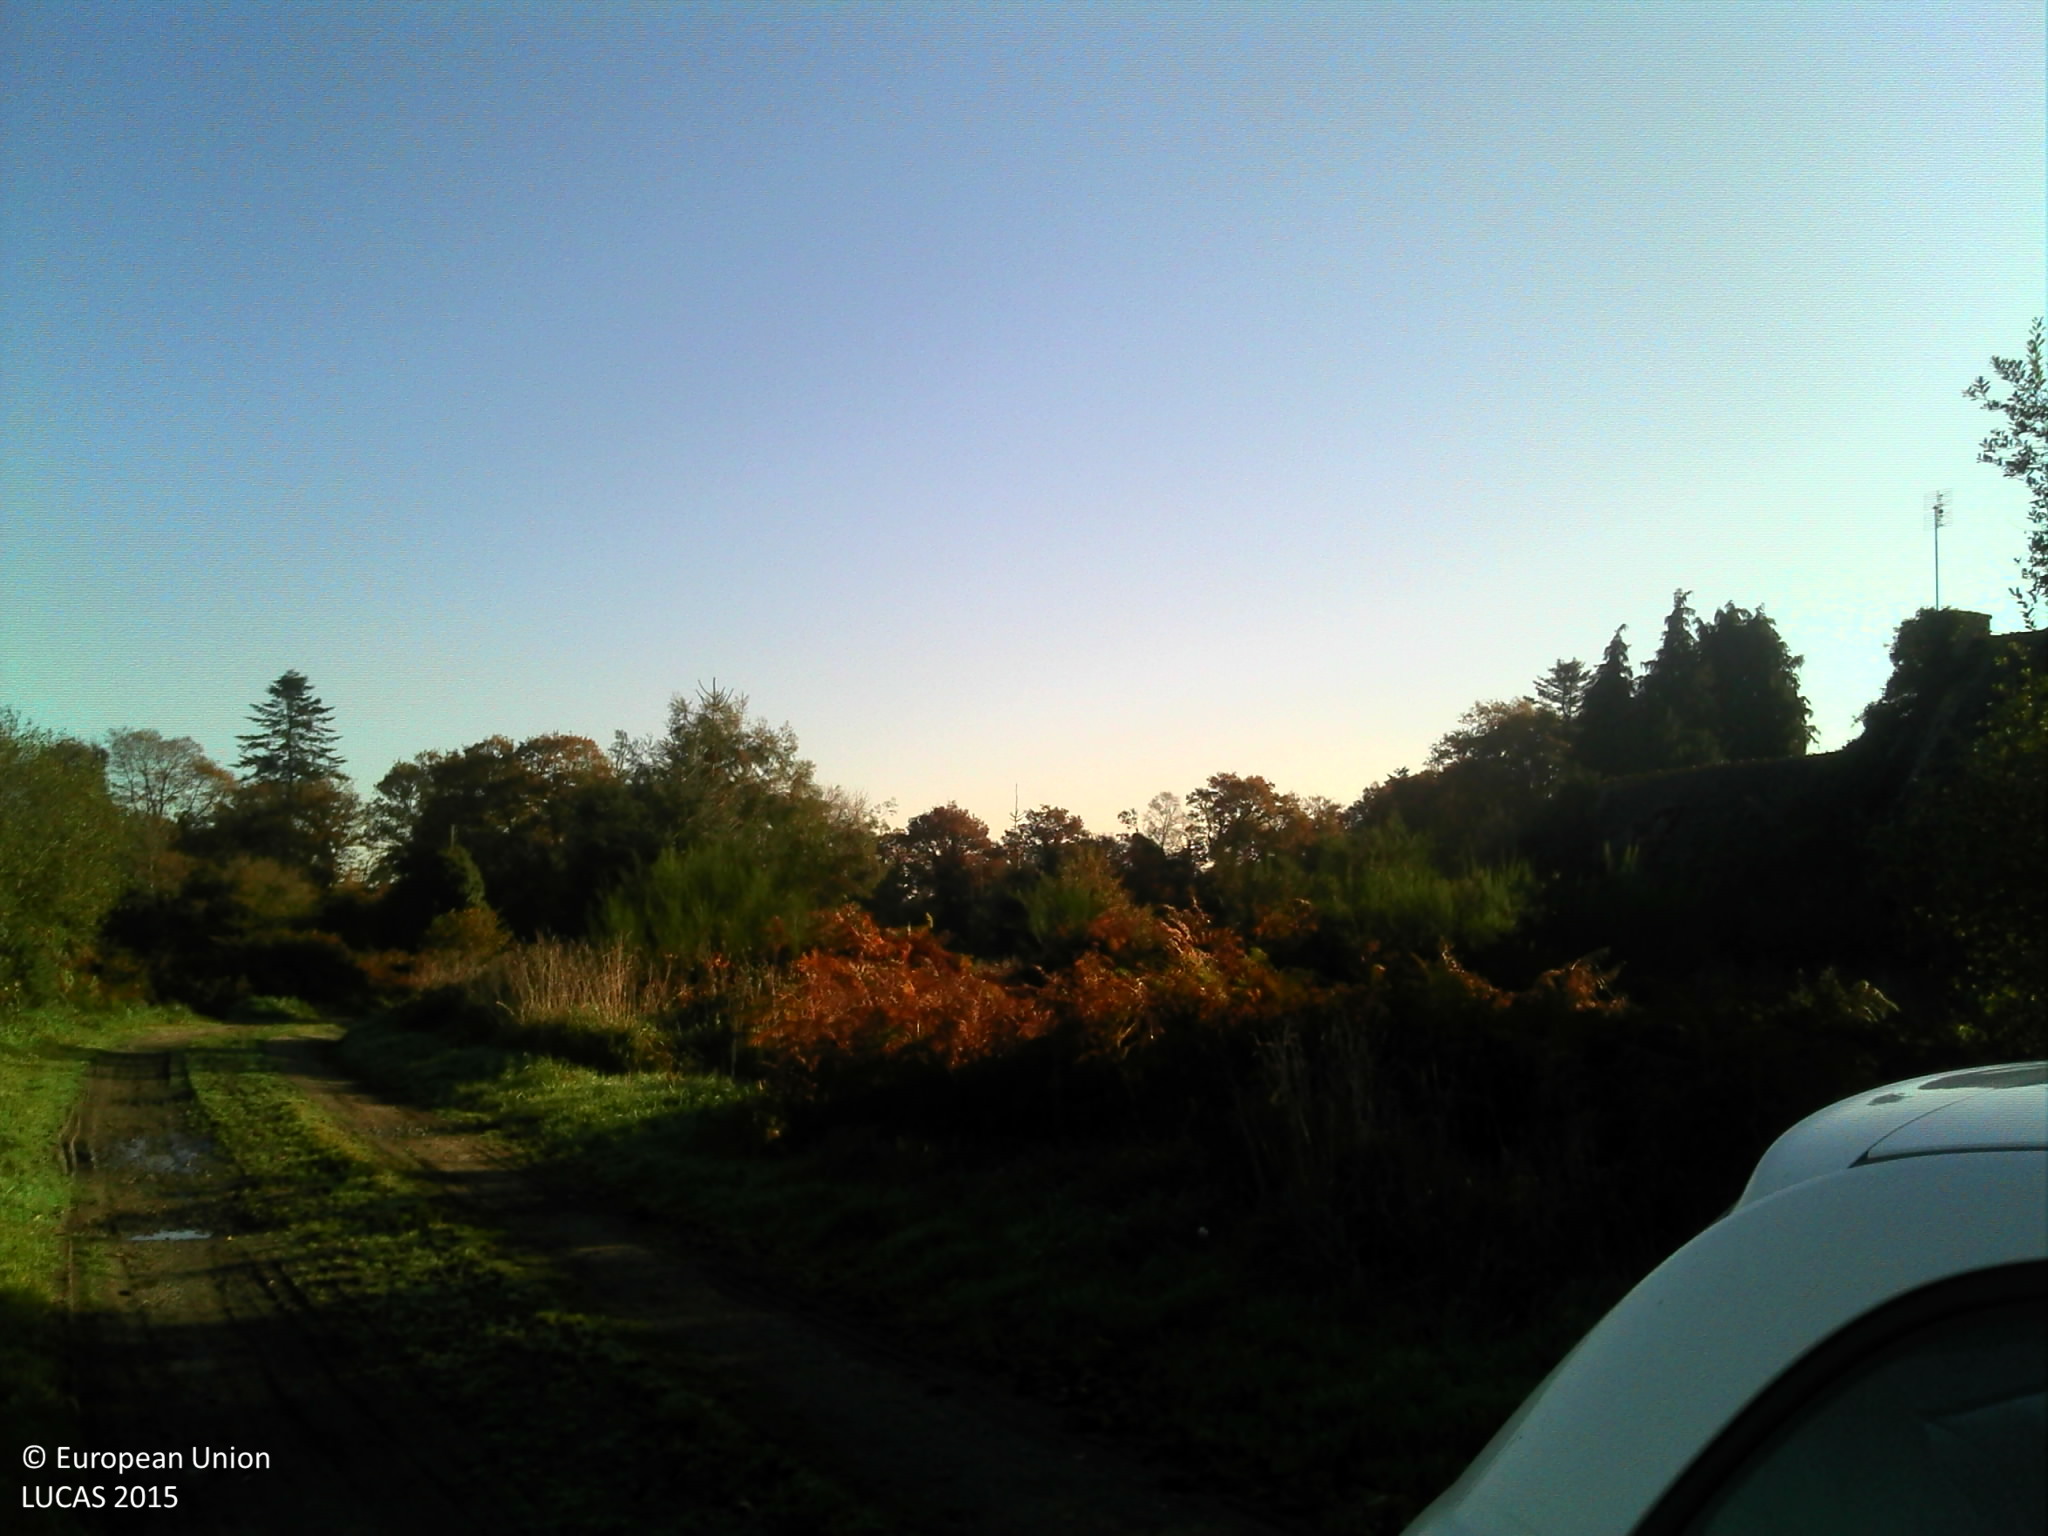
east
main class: Grassland
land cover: Grassland without tree/shrub cover
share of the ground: > 75 %
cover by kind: herbaceous plants 100 %
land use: Agriculture (excluding fallow land and kitchen gardens)
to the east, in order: Grassland without tree/shrub cover; Fences; Grassland without tree/shrub cover; Fences; Spontaneously vegetated surfaces; Grass margins; Paved roads, cycling and walking lanes; Grass margins; Electric lines; Spontaneously vegetated surfaces; Broadleaved woodland
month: November
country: FR
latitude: 48.1027
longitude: -3.3286
